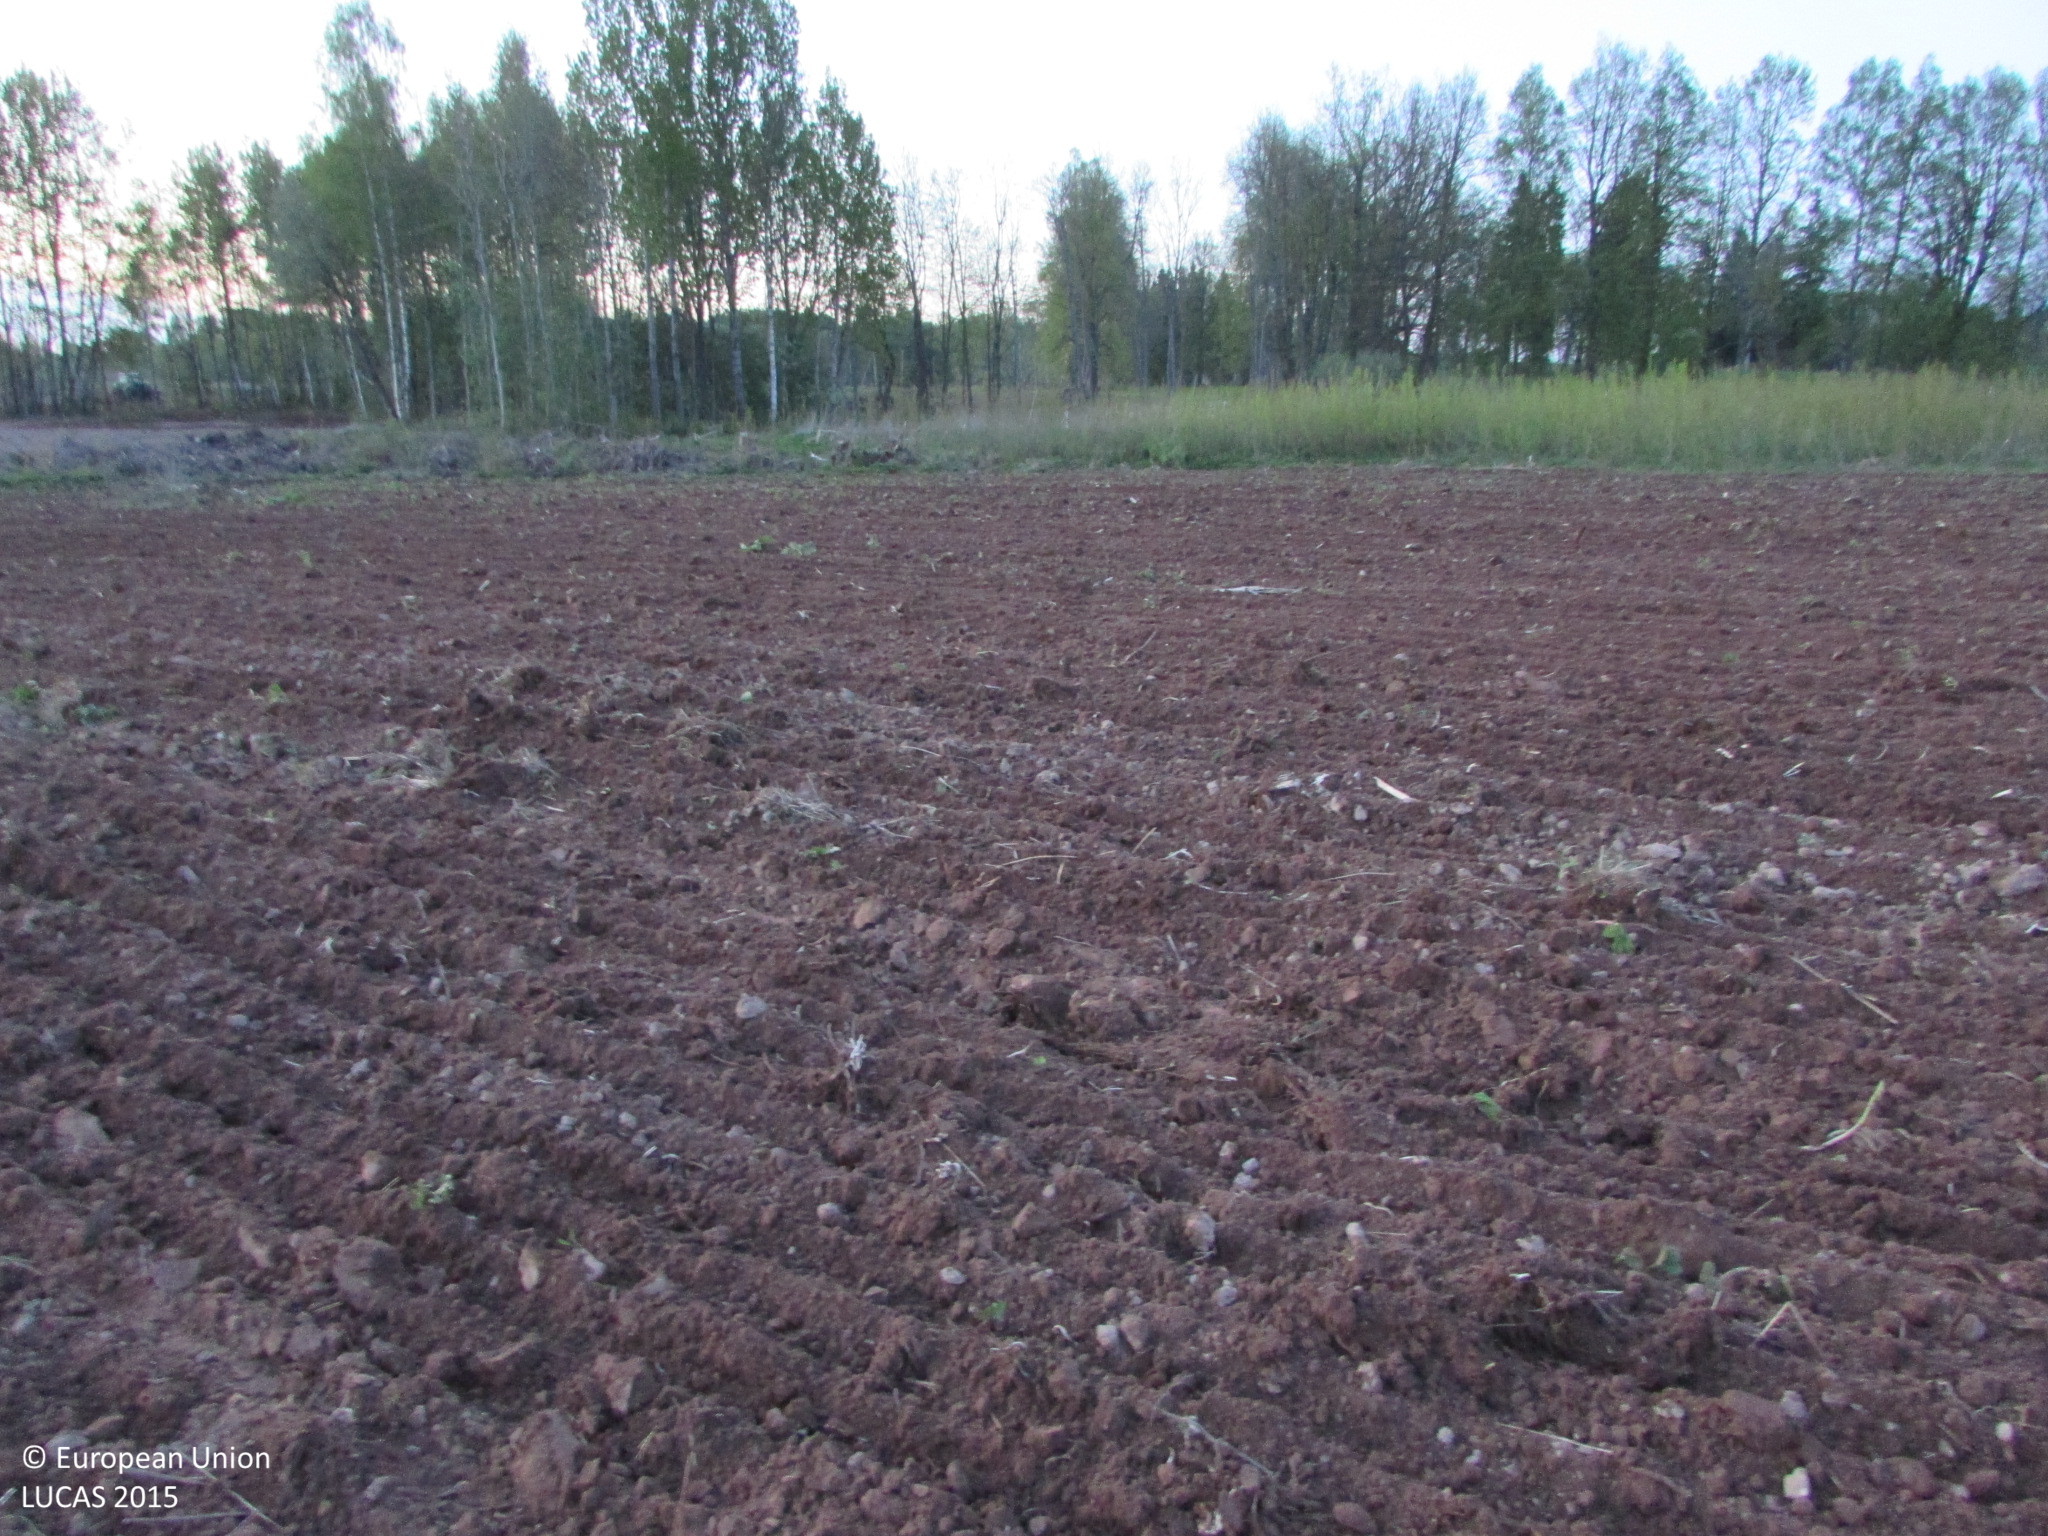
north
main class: Cropland
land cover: Oats
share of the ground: < 10 %
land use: Agriculture (excluding fallow land and kitchen gardens)
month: May
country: LV
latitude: 55.9017
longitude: 27.3053
